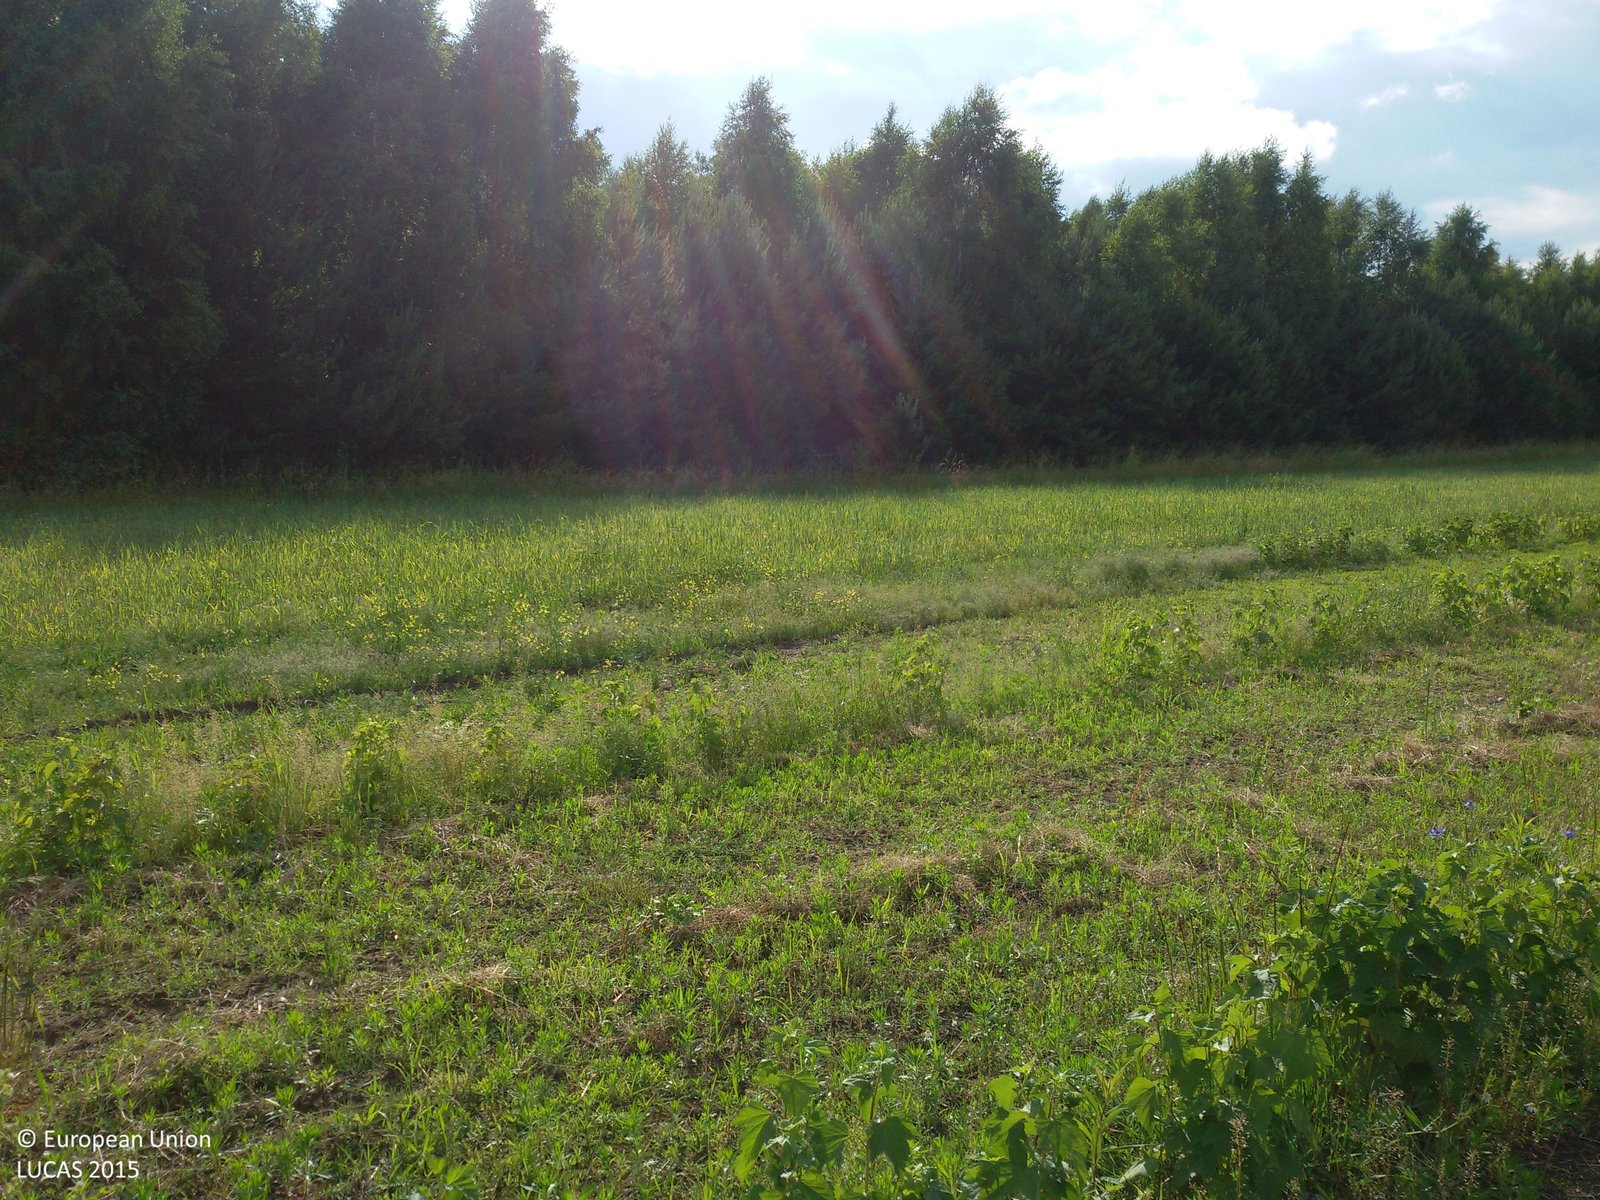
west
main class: Cropland
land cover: Other fruit trees and berries
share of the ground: > 75 %
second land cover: Grassland without tree/shrub cover
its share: > 75 %
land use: Agriculture (excluding fallow land and kitchen gardens)
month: June
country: PL
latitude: 50.9180
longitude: 21.7616
